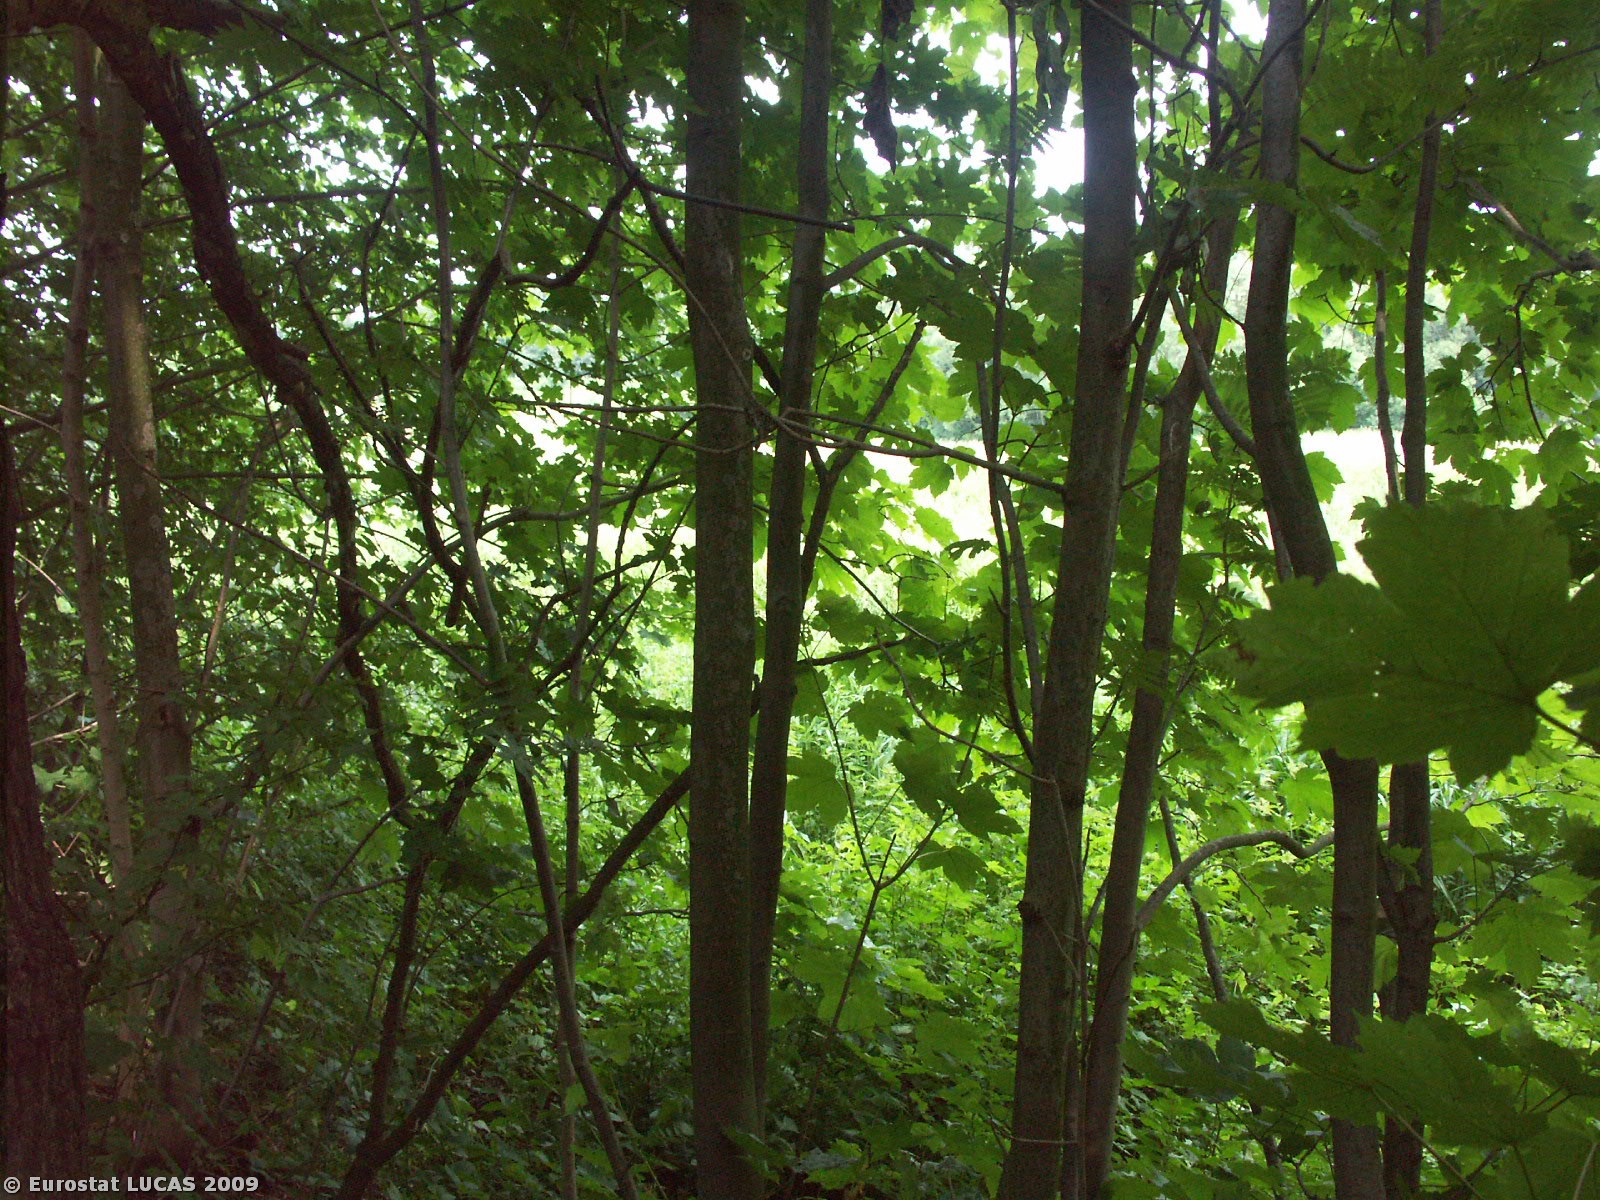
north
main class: Woodland
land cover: Broadleaved woodland
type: floodplain forest
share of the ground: > 75 %
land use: Forestry
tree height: > 5 m
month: June
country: CZ
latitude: 50.0968
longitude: 16.6764
